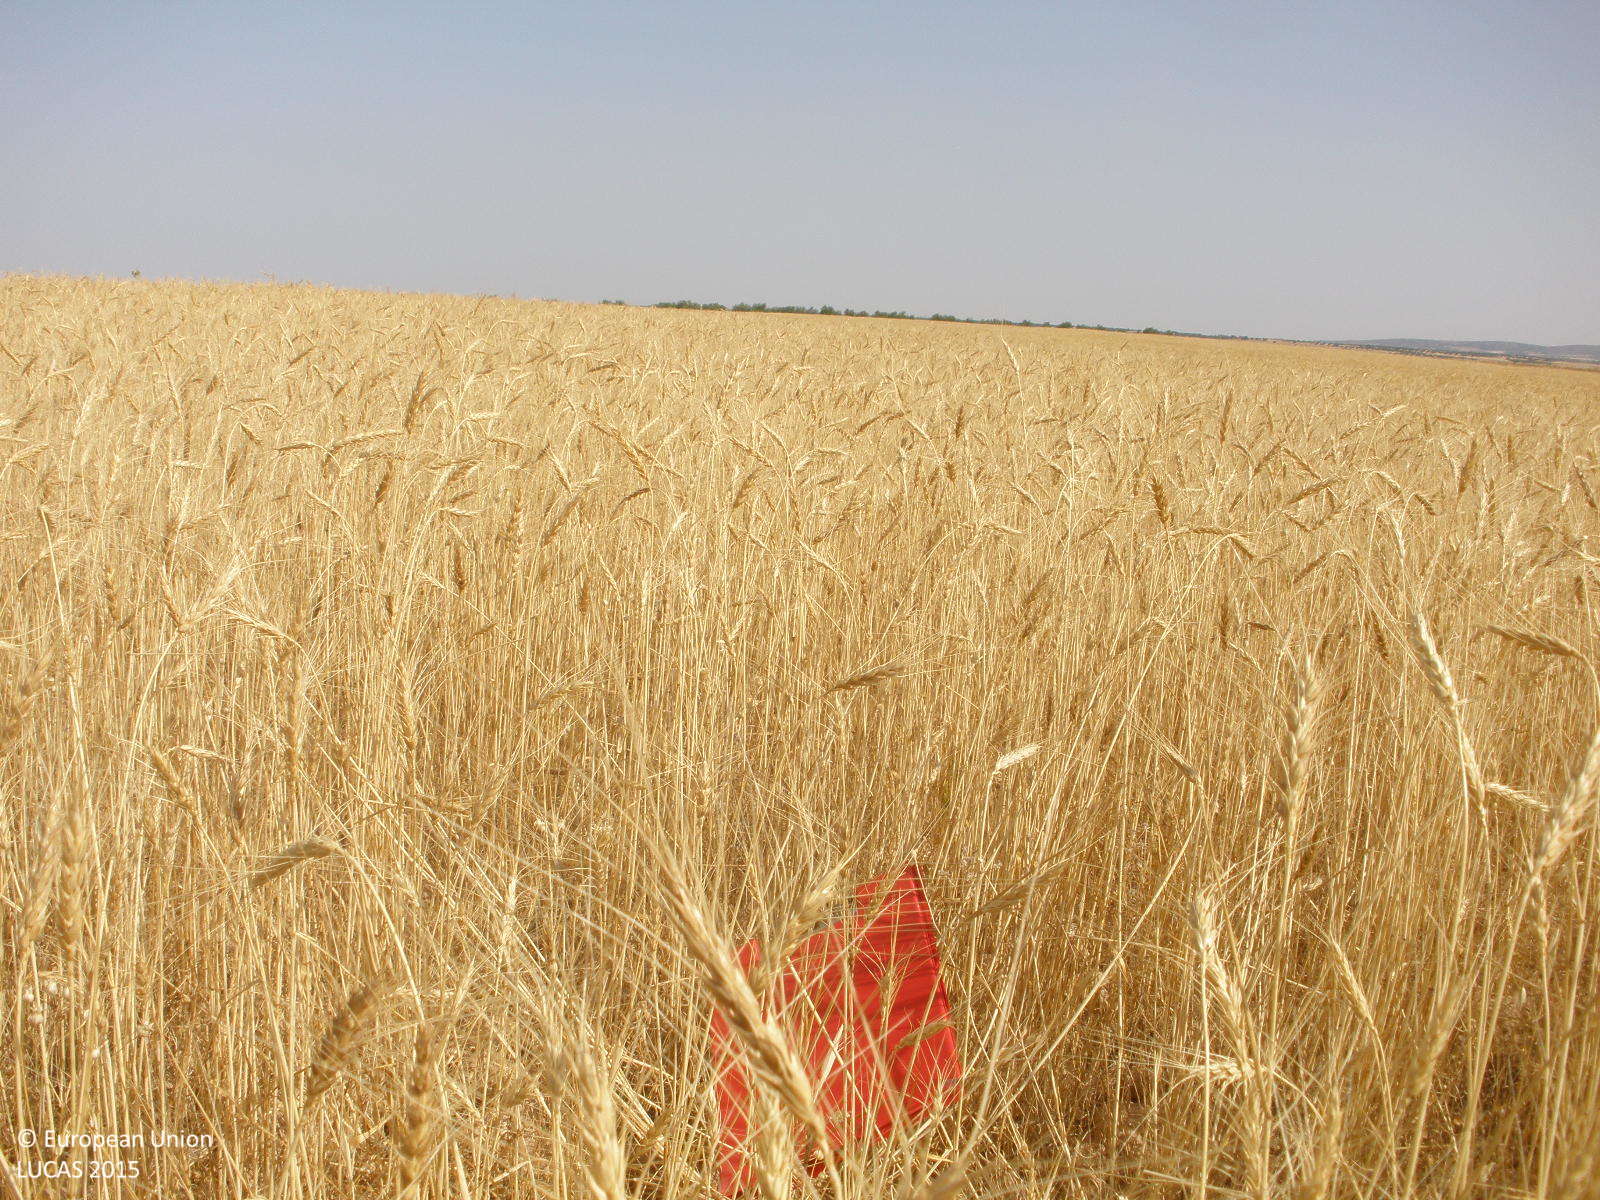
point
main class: Cropland
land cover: Barley
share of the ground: > 75 %
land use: Agriculture (excluding fallow land and kitchen gardens)
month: July
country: ES
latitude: 39.7482
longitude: -3.3875
